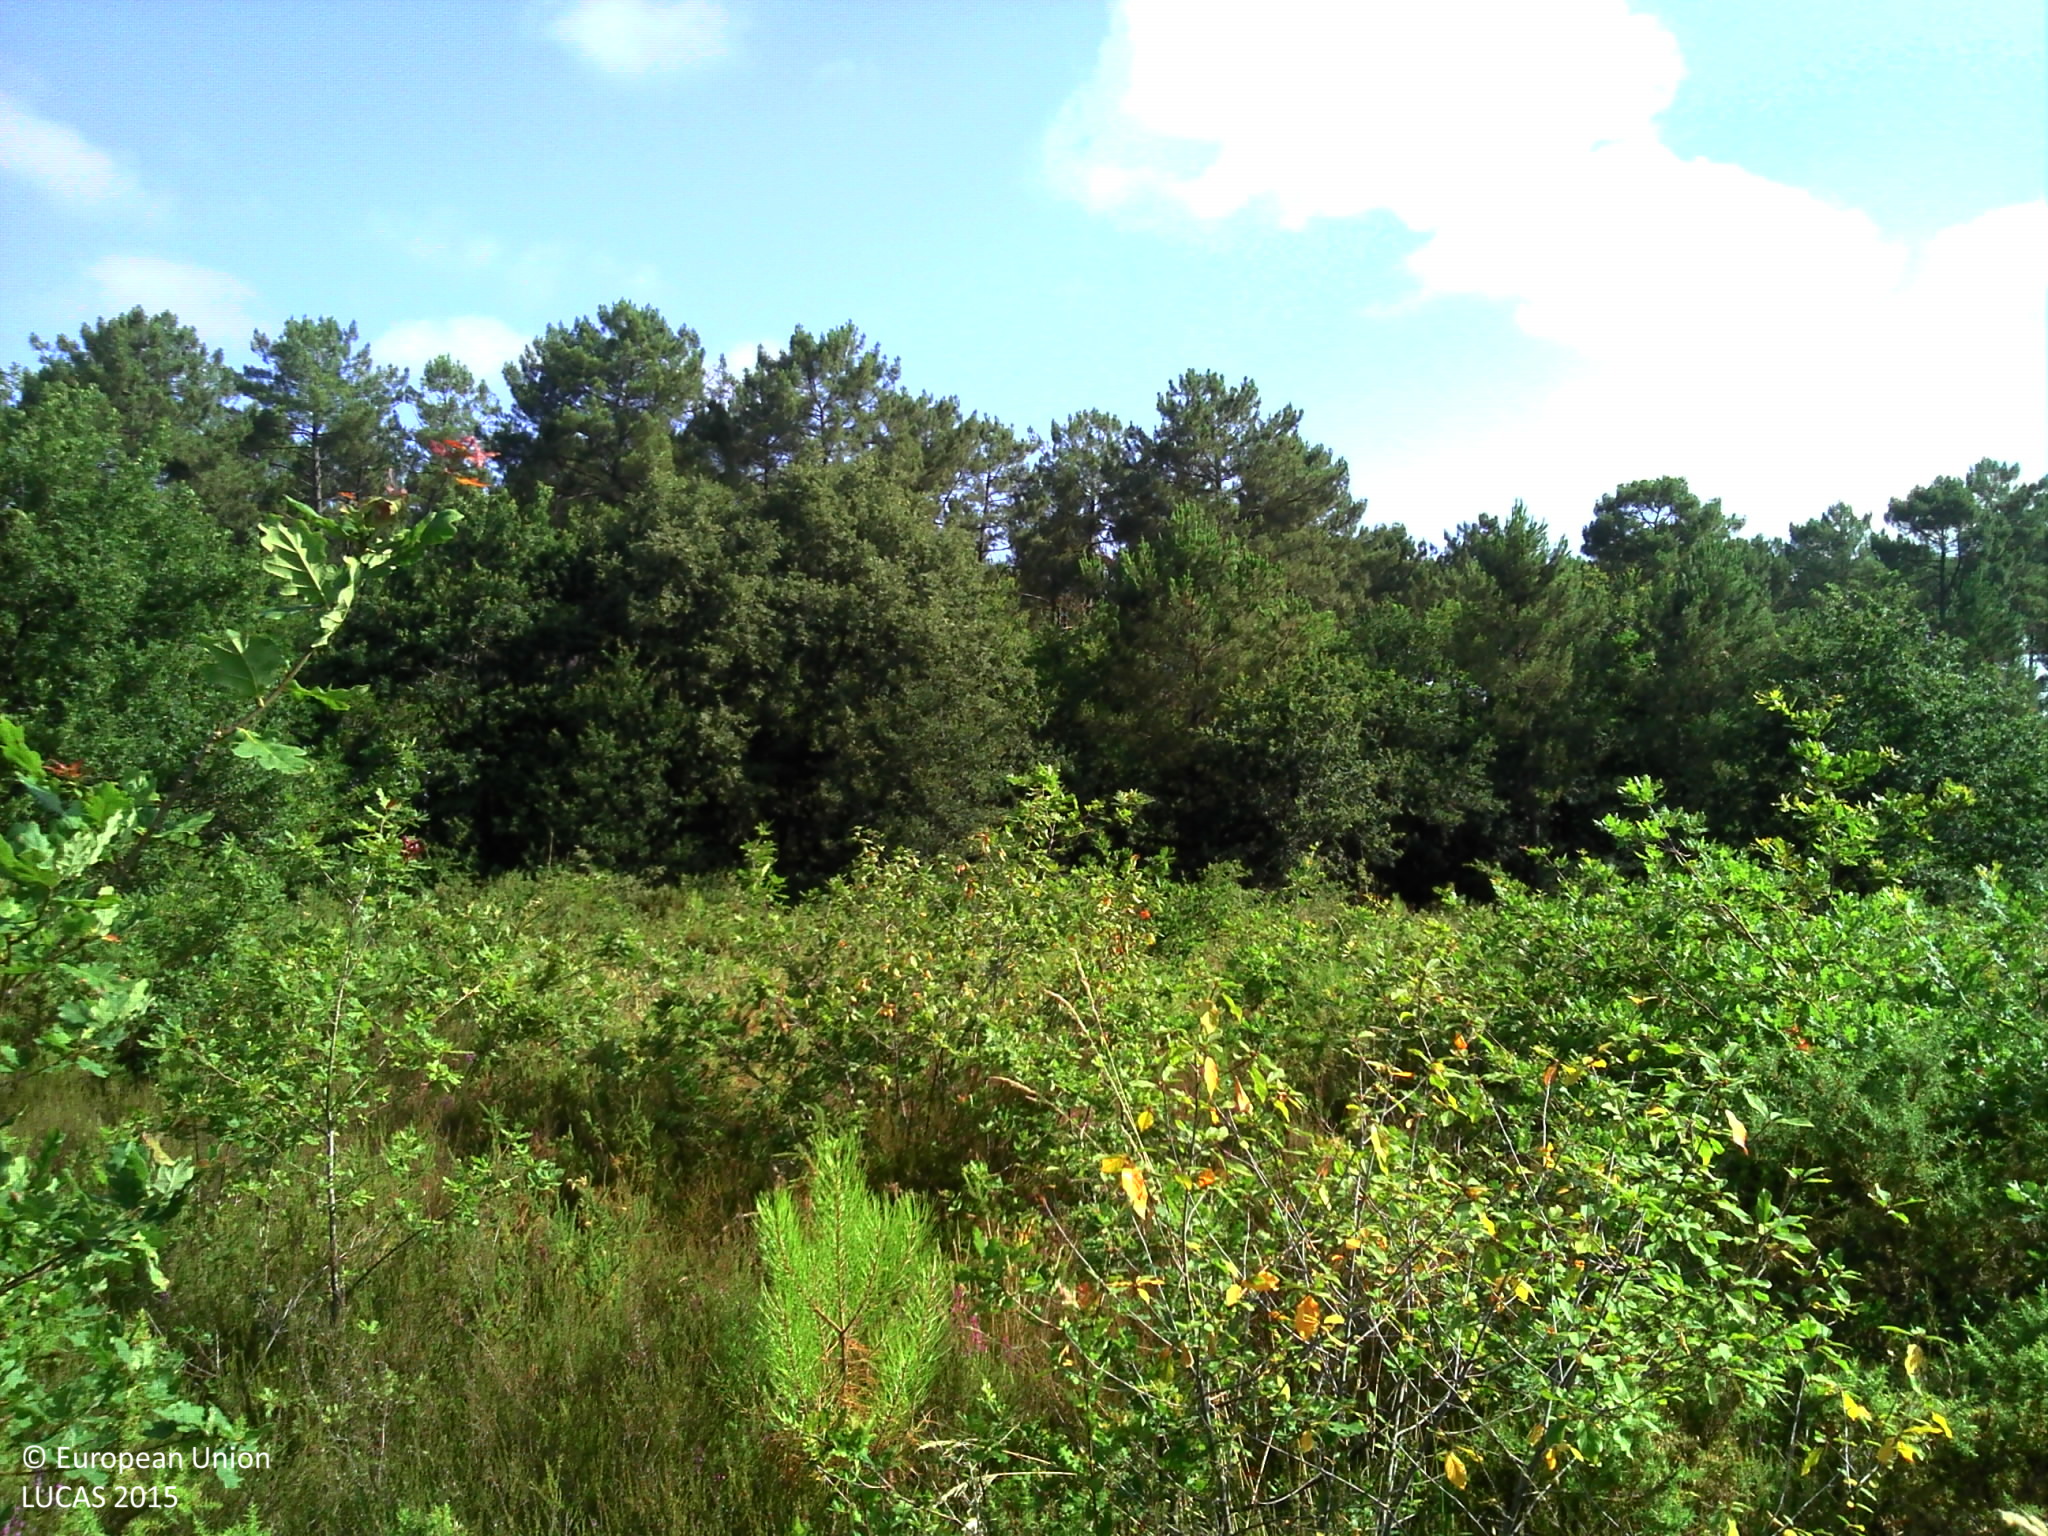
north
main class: Woodland
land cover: Broadleaved woodland
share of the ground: > 75 %
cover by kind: broadleaved forest trees 65 %, shrubs 15 %, herbaceous plants 15 %, coniferous forest trees 5 %
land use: Forestry
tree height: > 5 m
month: July
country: FR
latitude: 43.7141
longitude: -1.1246
